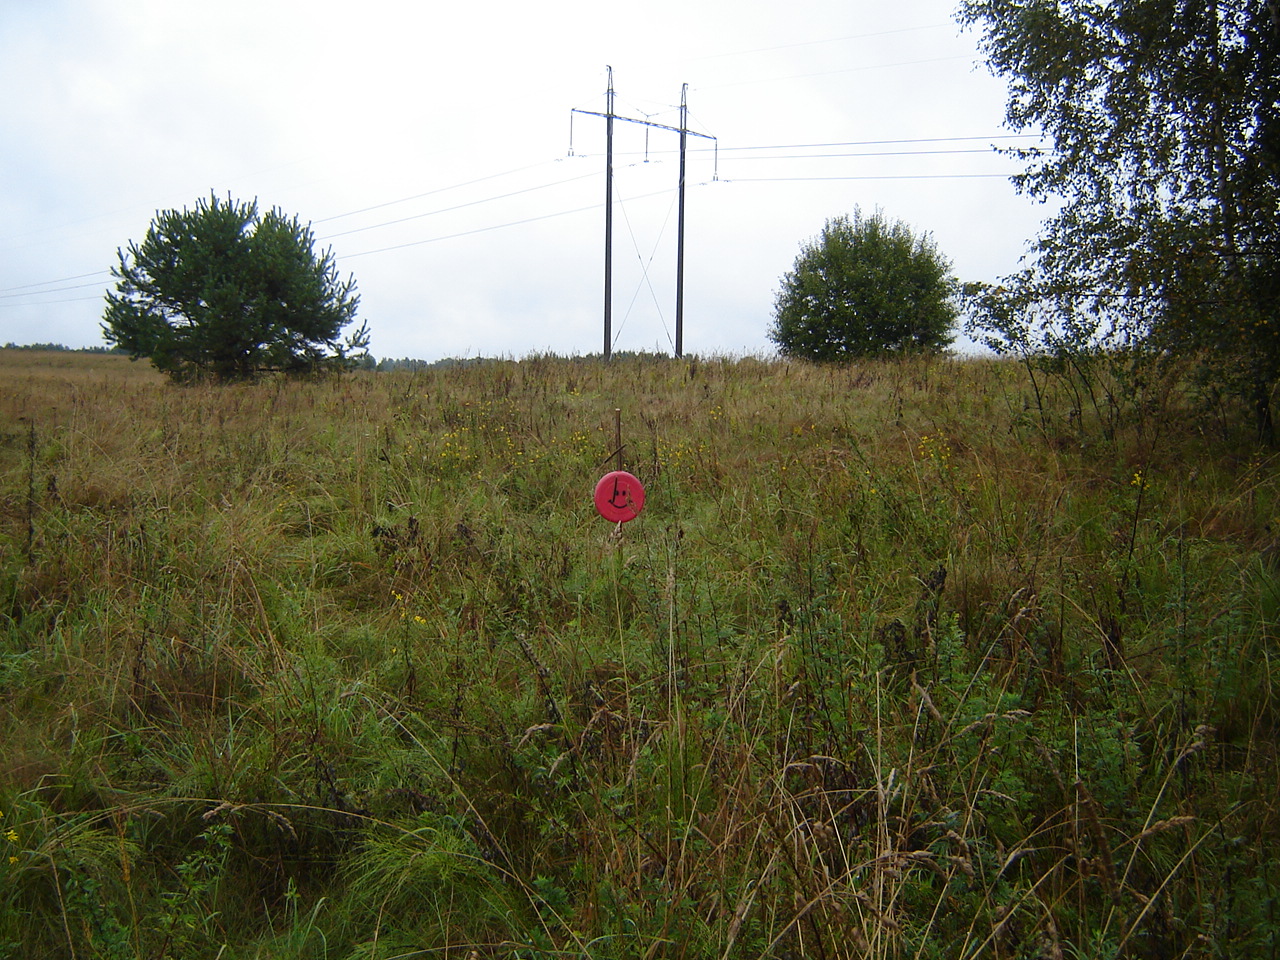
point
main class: Grassland
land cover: Spontaneously vegetated surfaces
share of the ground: > 75 %
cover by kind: herbaceous plants 100 %
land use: Fallow land
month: September
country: LT
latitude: 55.0189
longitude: 25.3399
